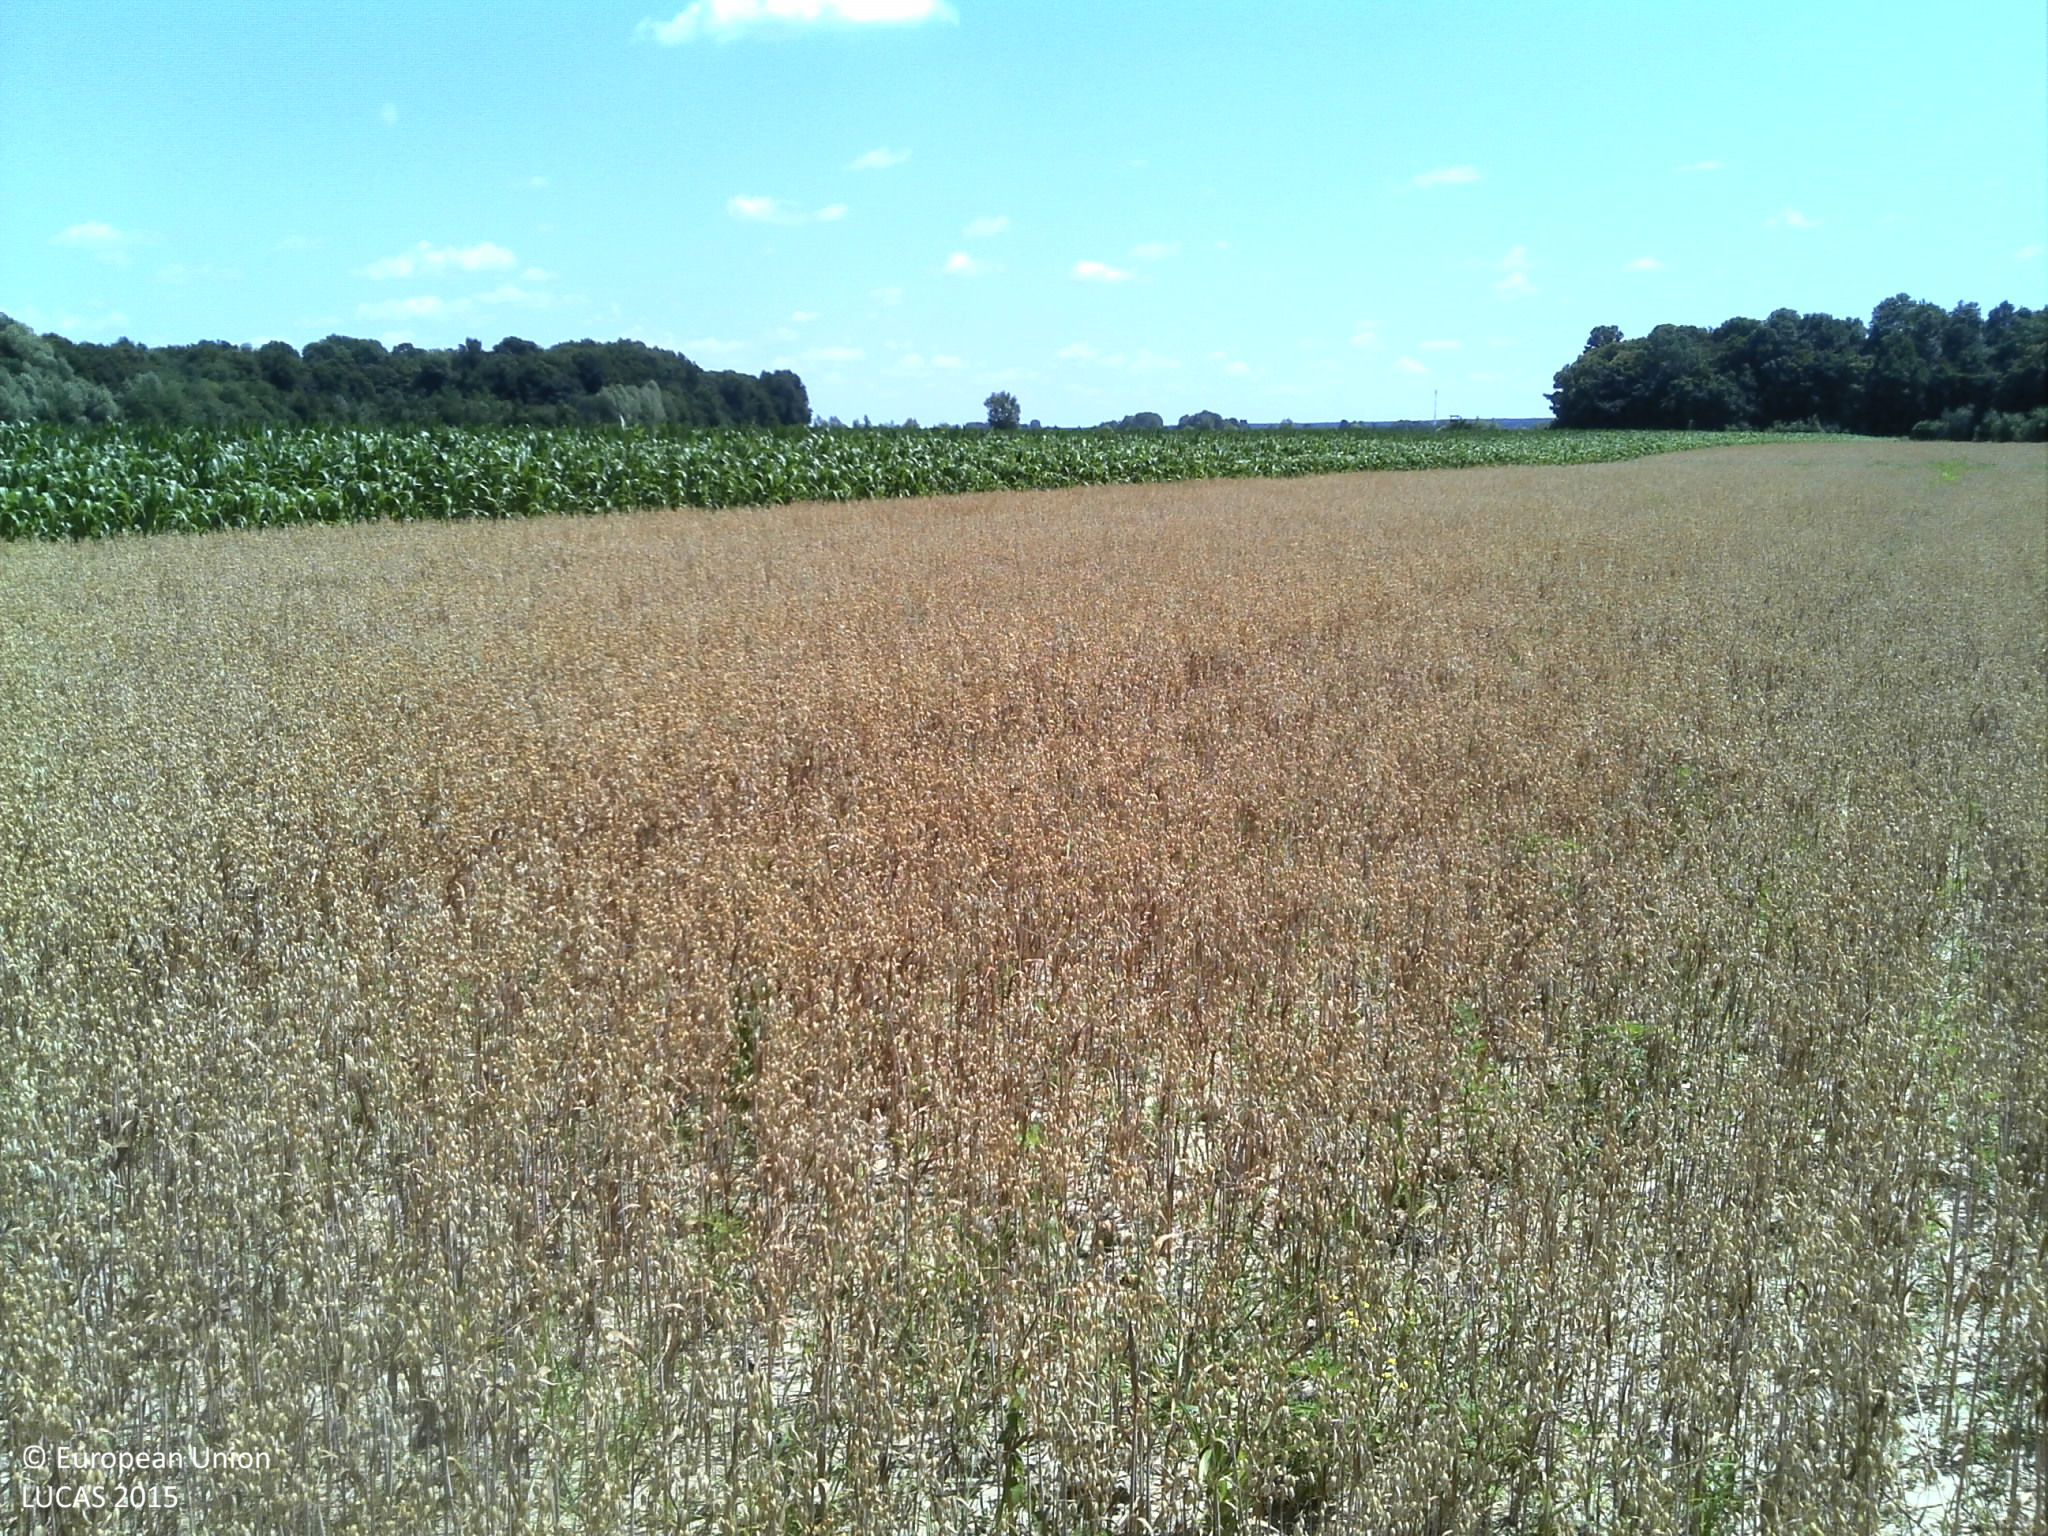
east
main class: Cropland
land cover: Oats
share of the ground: > 75 %
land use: Agriculture (excluding fallow land and kitchen gardens)
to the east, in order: Oats; Maize; Grass margins; Maize
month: July
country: HR
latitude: 45.8023
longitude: 16.9098
